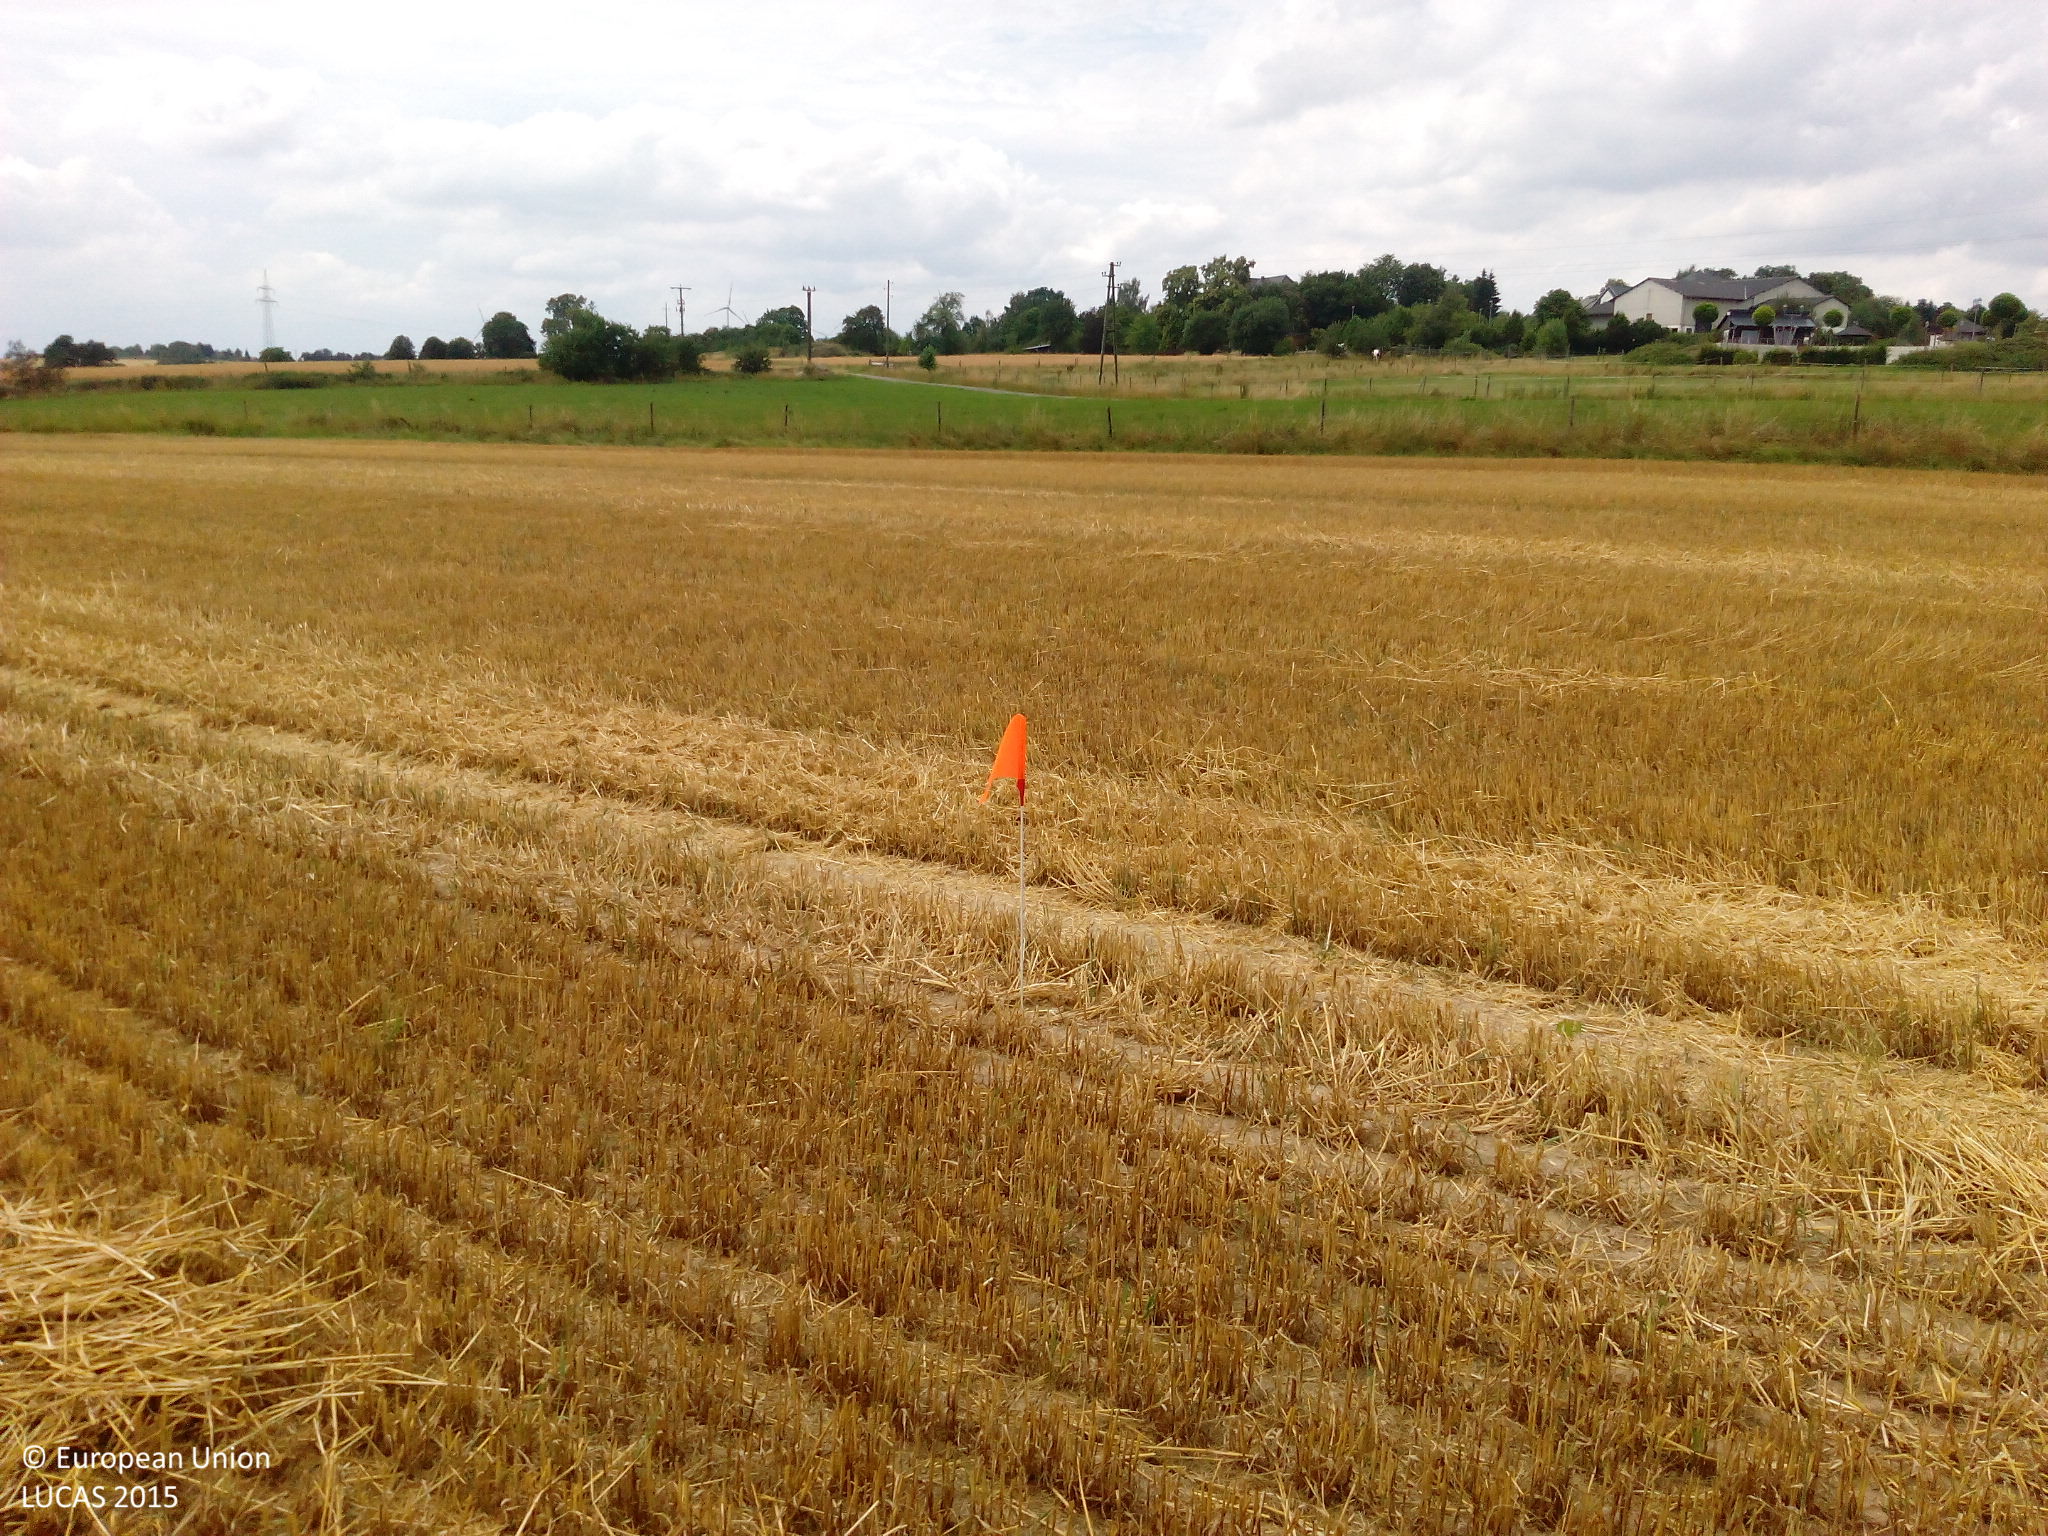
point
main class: Cropland
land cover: Barley
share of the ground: < 10 %
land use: Agriculture (excluding fallow land and kitchen gardens)
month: July
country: DE
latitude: 49.9770
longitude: 7.5043
